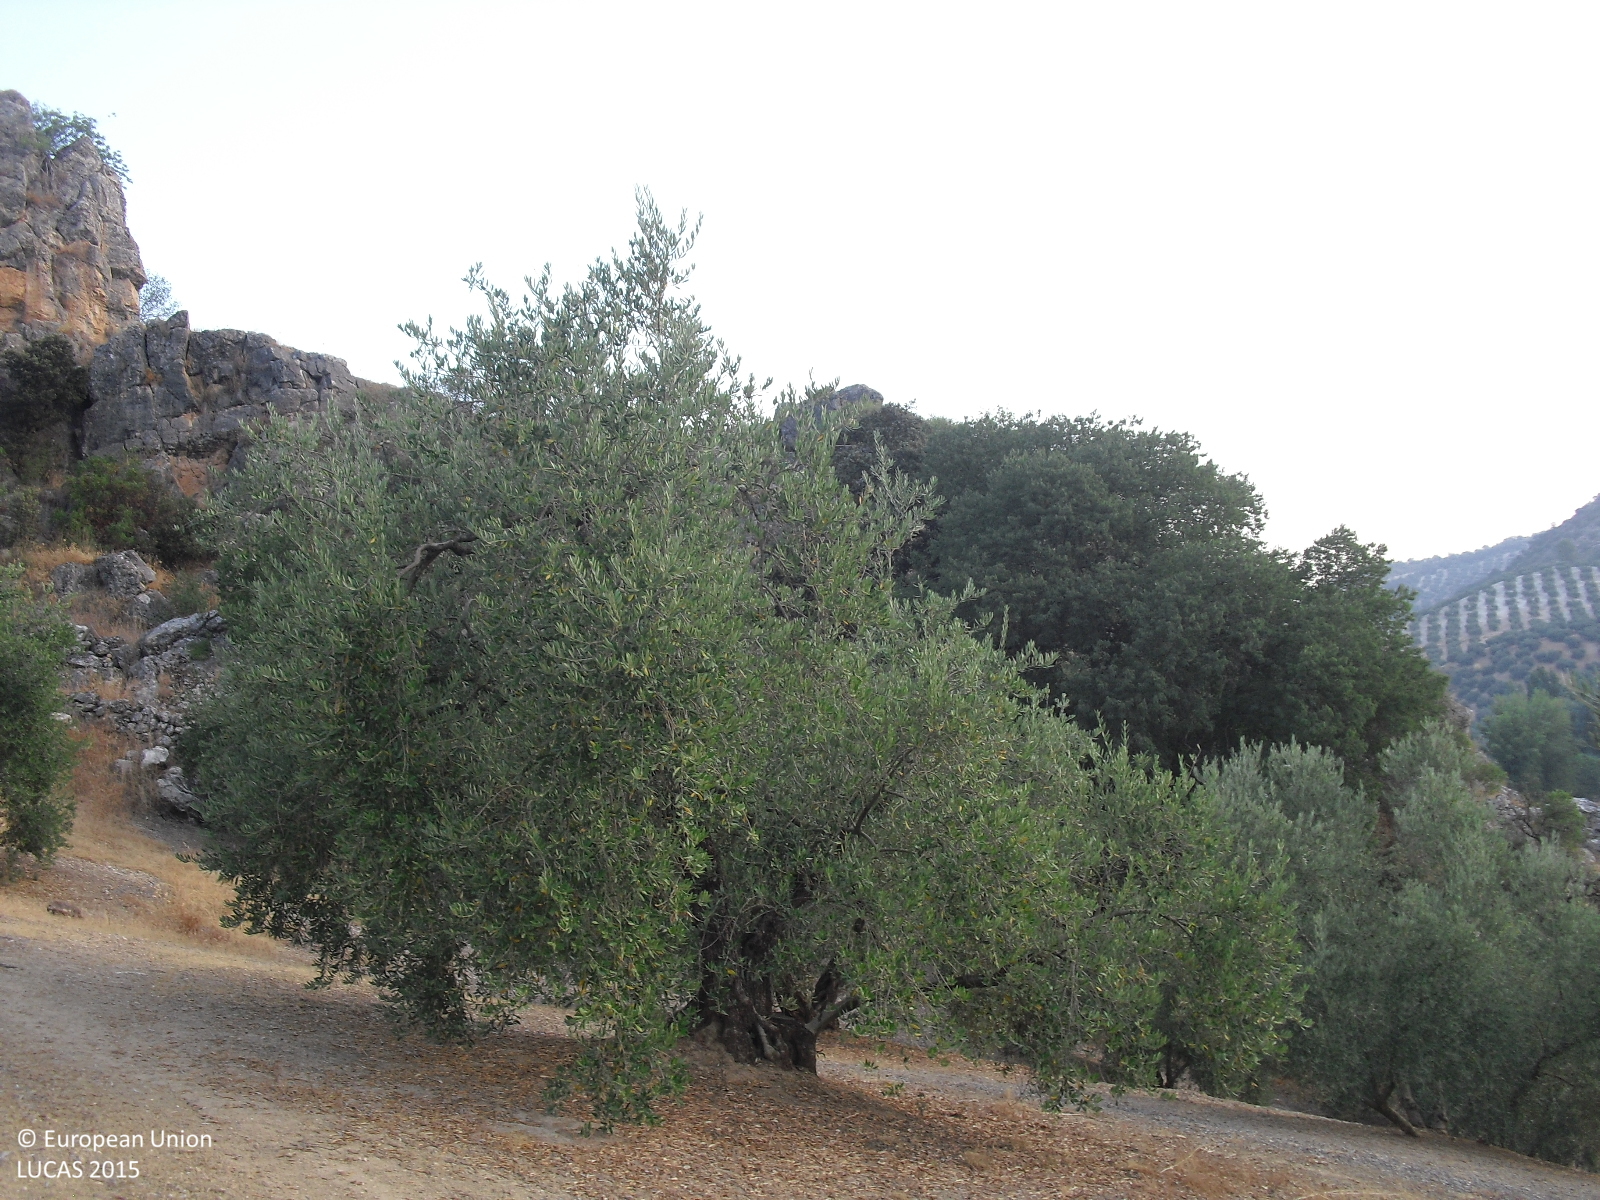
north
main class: Cropland
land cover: Olive groves
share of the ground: 25 - 50 %
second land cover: Other bare soil
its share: > 75 %
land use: Agriculture (excluding fallow land and kitchen gardens)
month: August
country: ES
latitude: 37.2830
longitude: -4.1973
